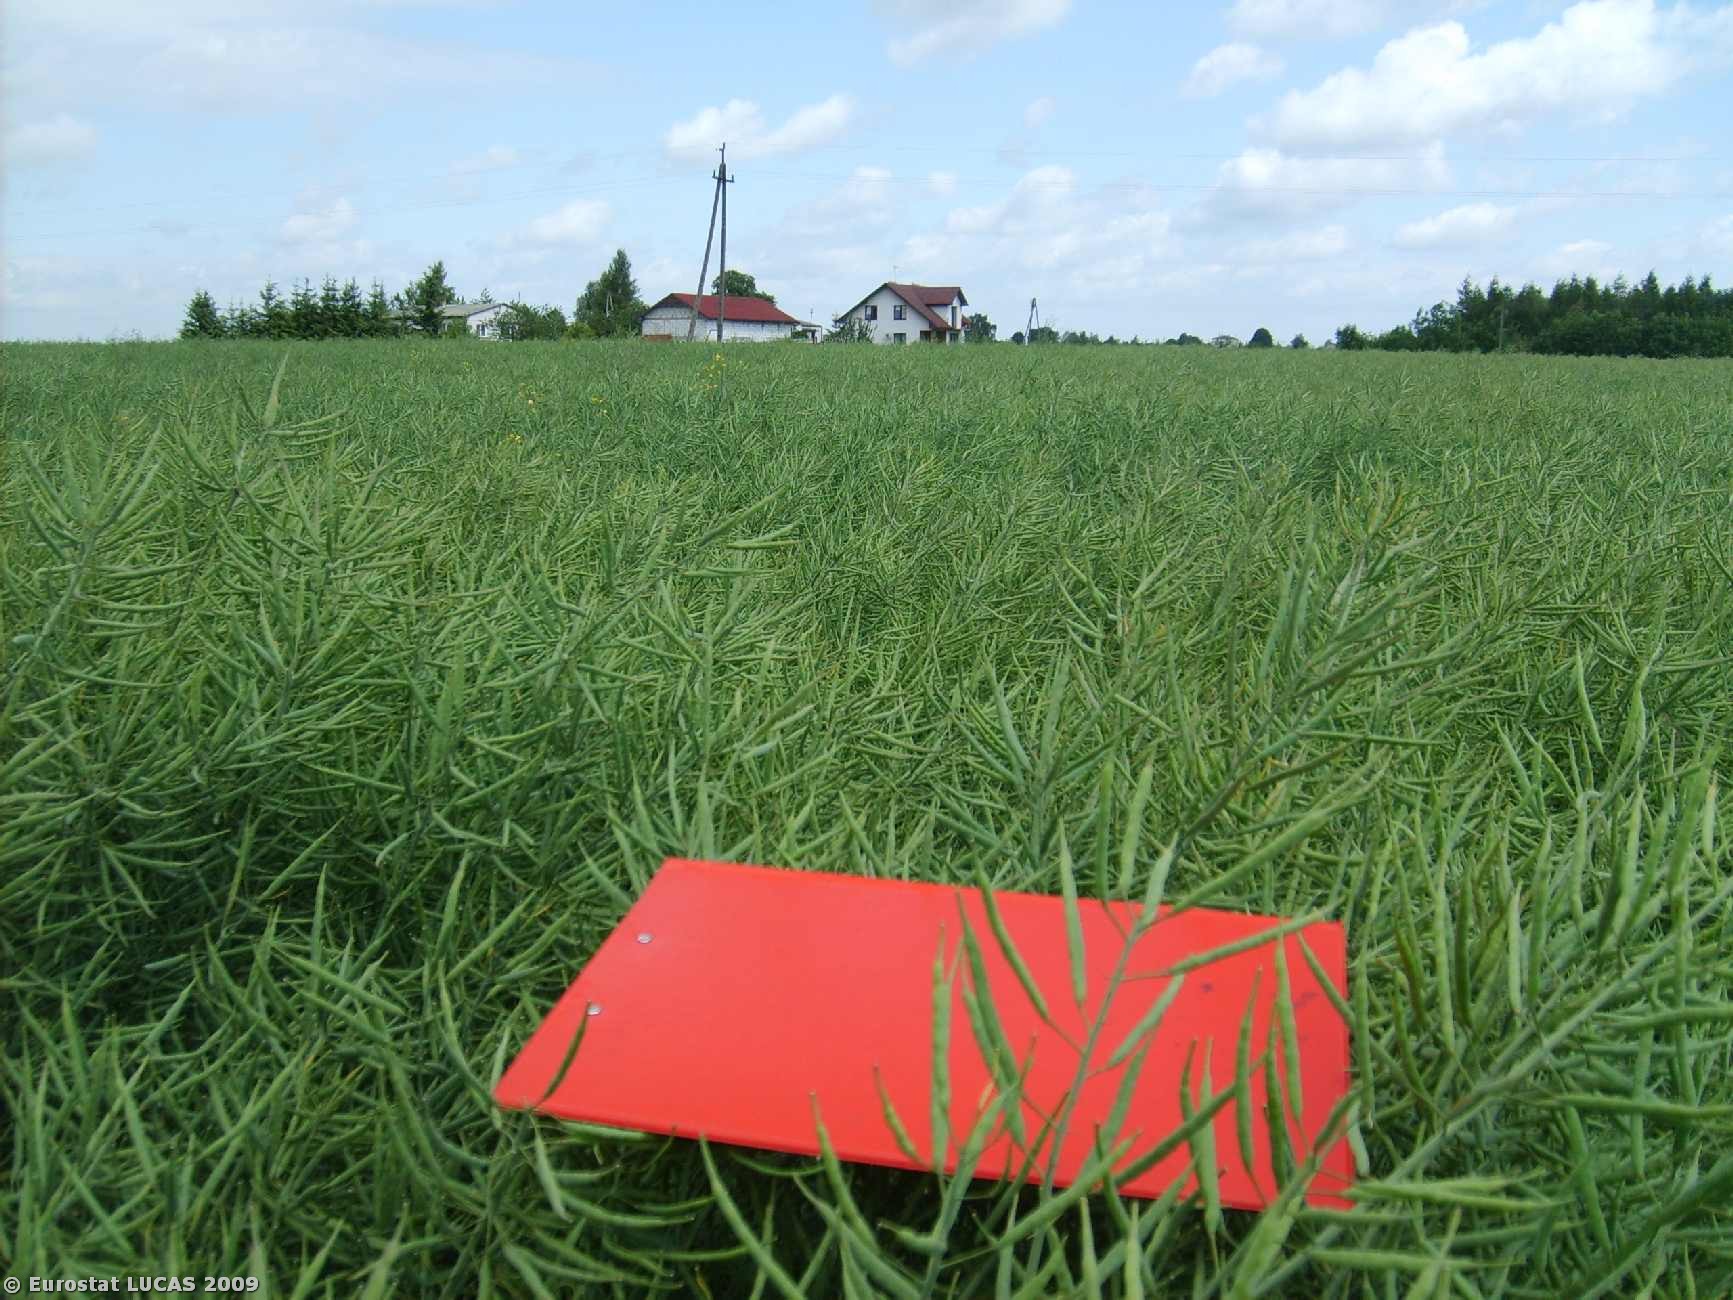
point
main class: Cropland
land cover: Rape and turnip rape
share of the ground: > 75 %
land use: Agriculture (excluding fallow land and kitchen gardens)
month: June
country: PL
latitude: 51.1596
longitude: 22.4048
